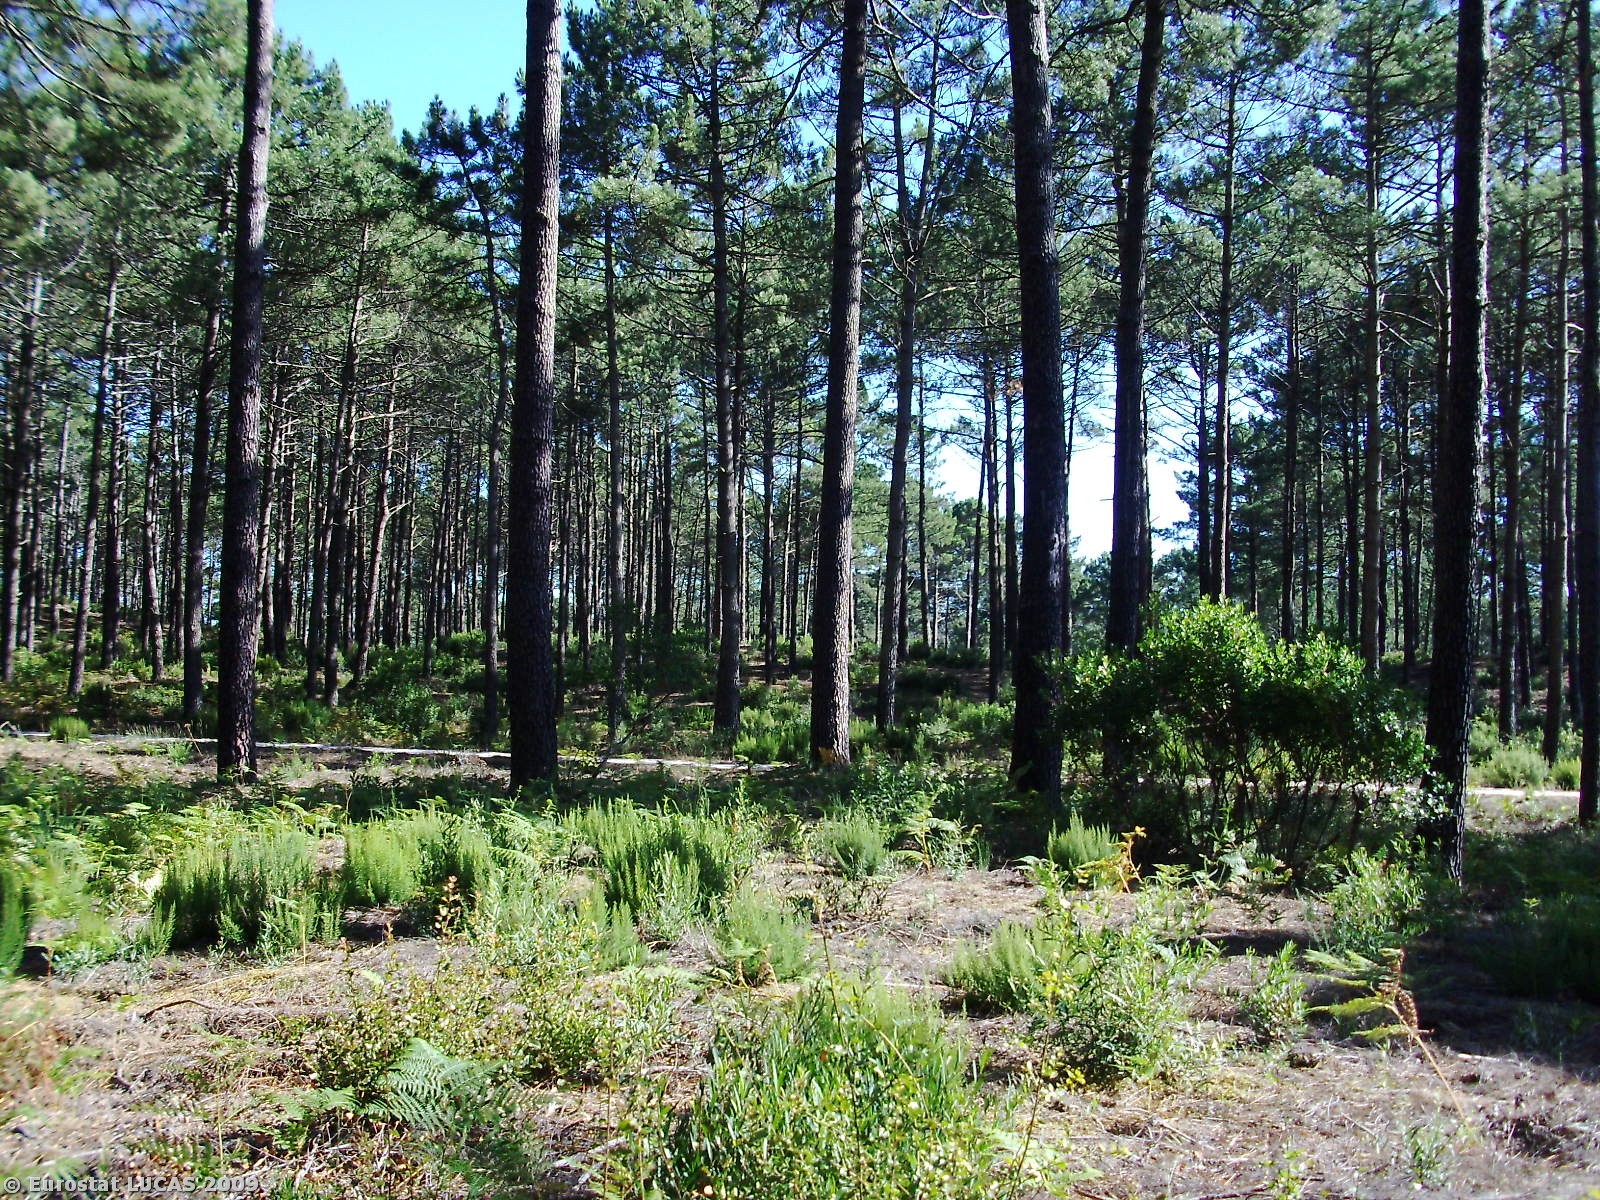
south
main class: Woodland
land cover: Coniferous woodland
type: coniferous forest of the mediterranean region
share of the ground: > 75 %
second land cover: Shrubland with sparse tree cover
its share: 10 - 25 %
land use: Forestry
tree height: > 5 m
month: July
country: PT
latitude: 39.7639
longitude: -8.9905
